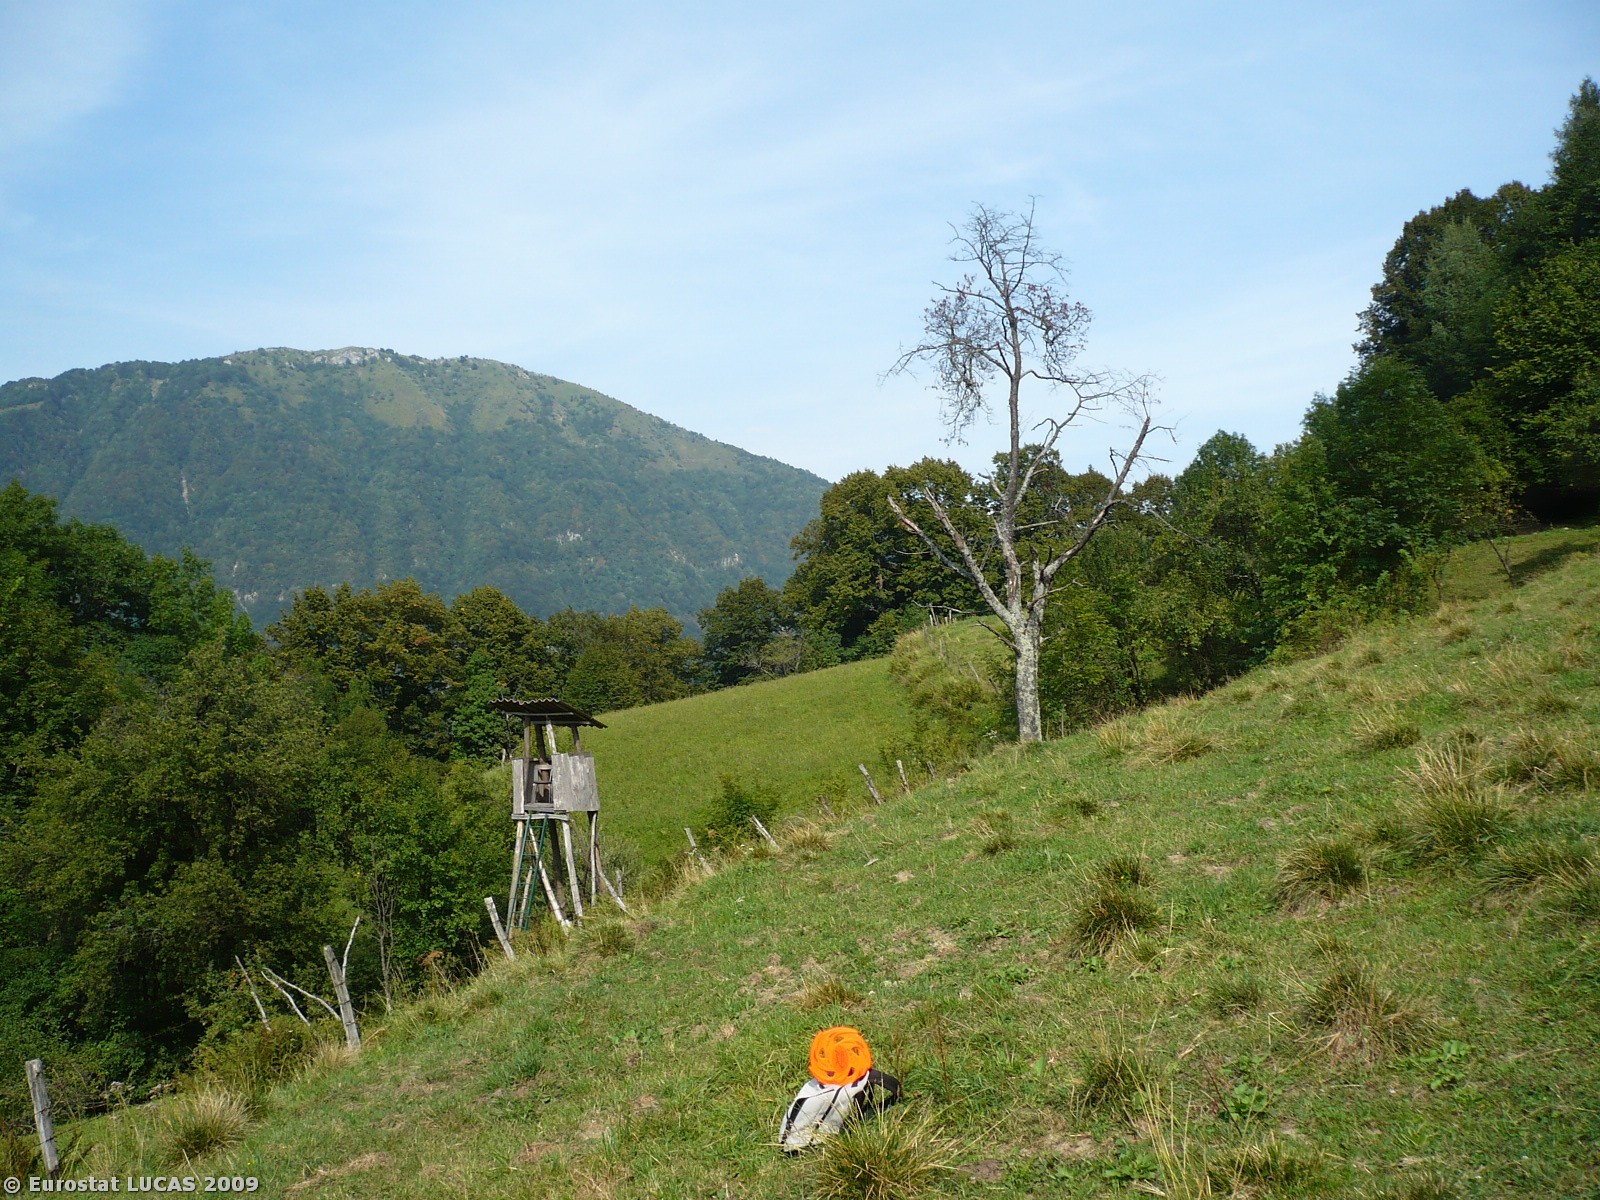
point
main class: Grassland
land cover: Grassland without tree/shrub cover
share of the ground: > 75 %
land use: Agriculture (excluding fallow land and kitchen gardens)
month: August
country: SI
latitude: 46.1983
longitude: 13.6639
